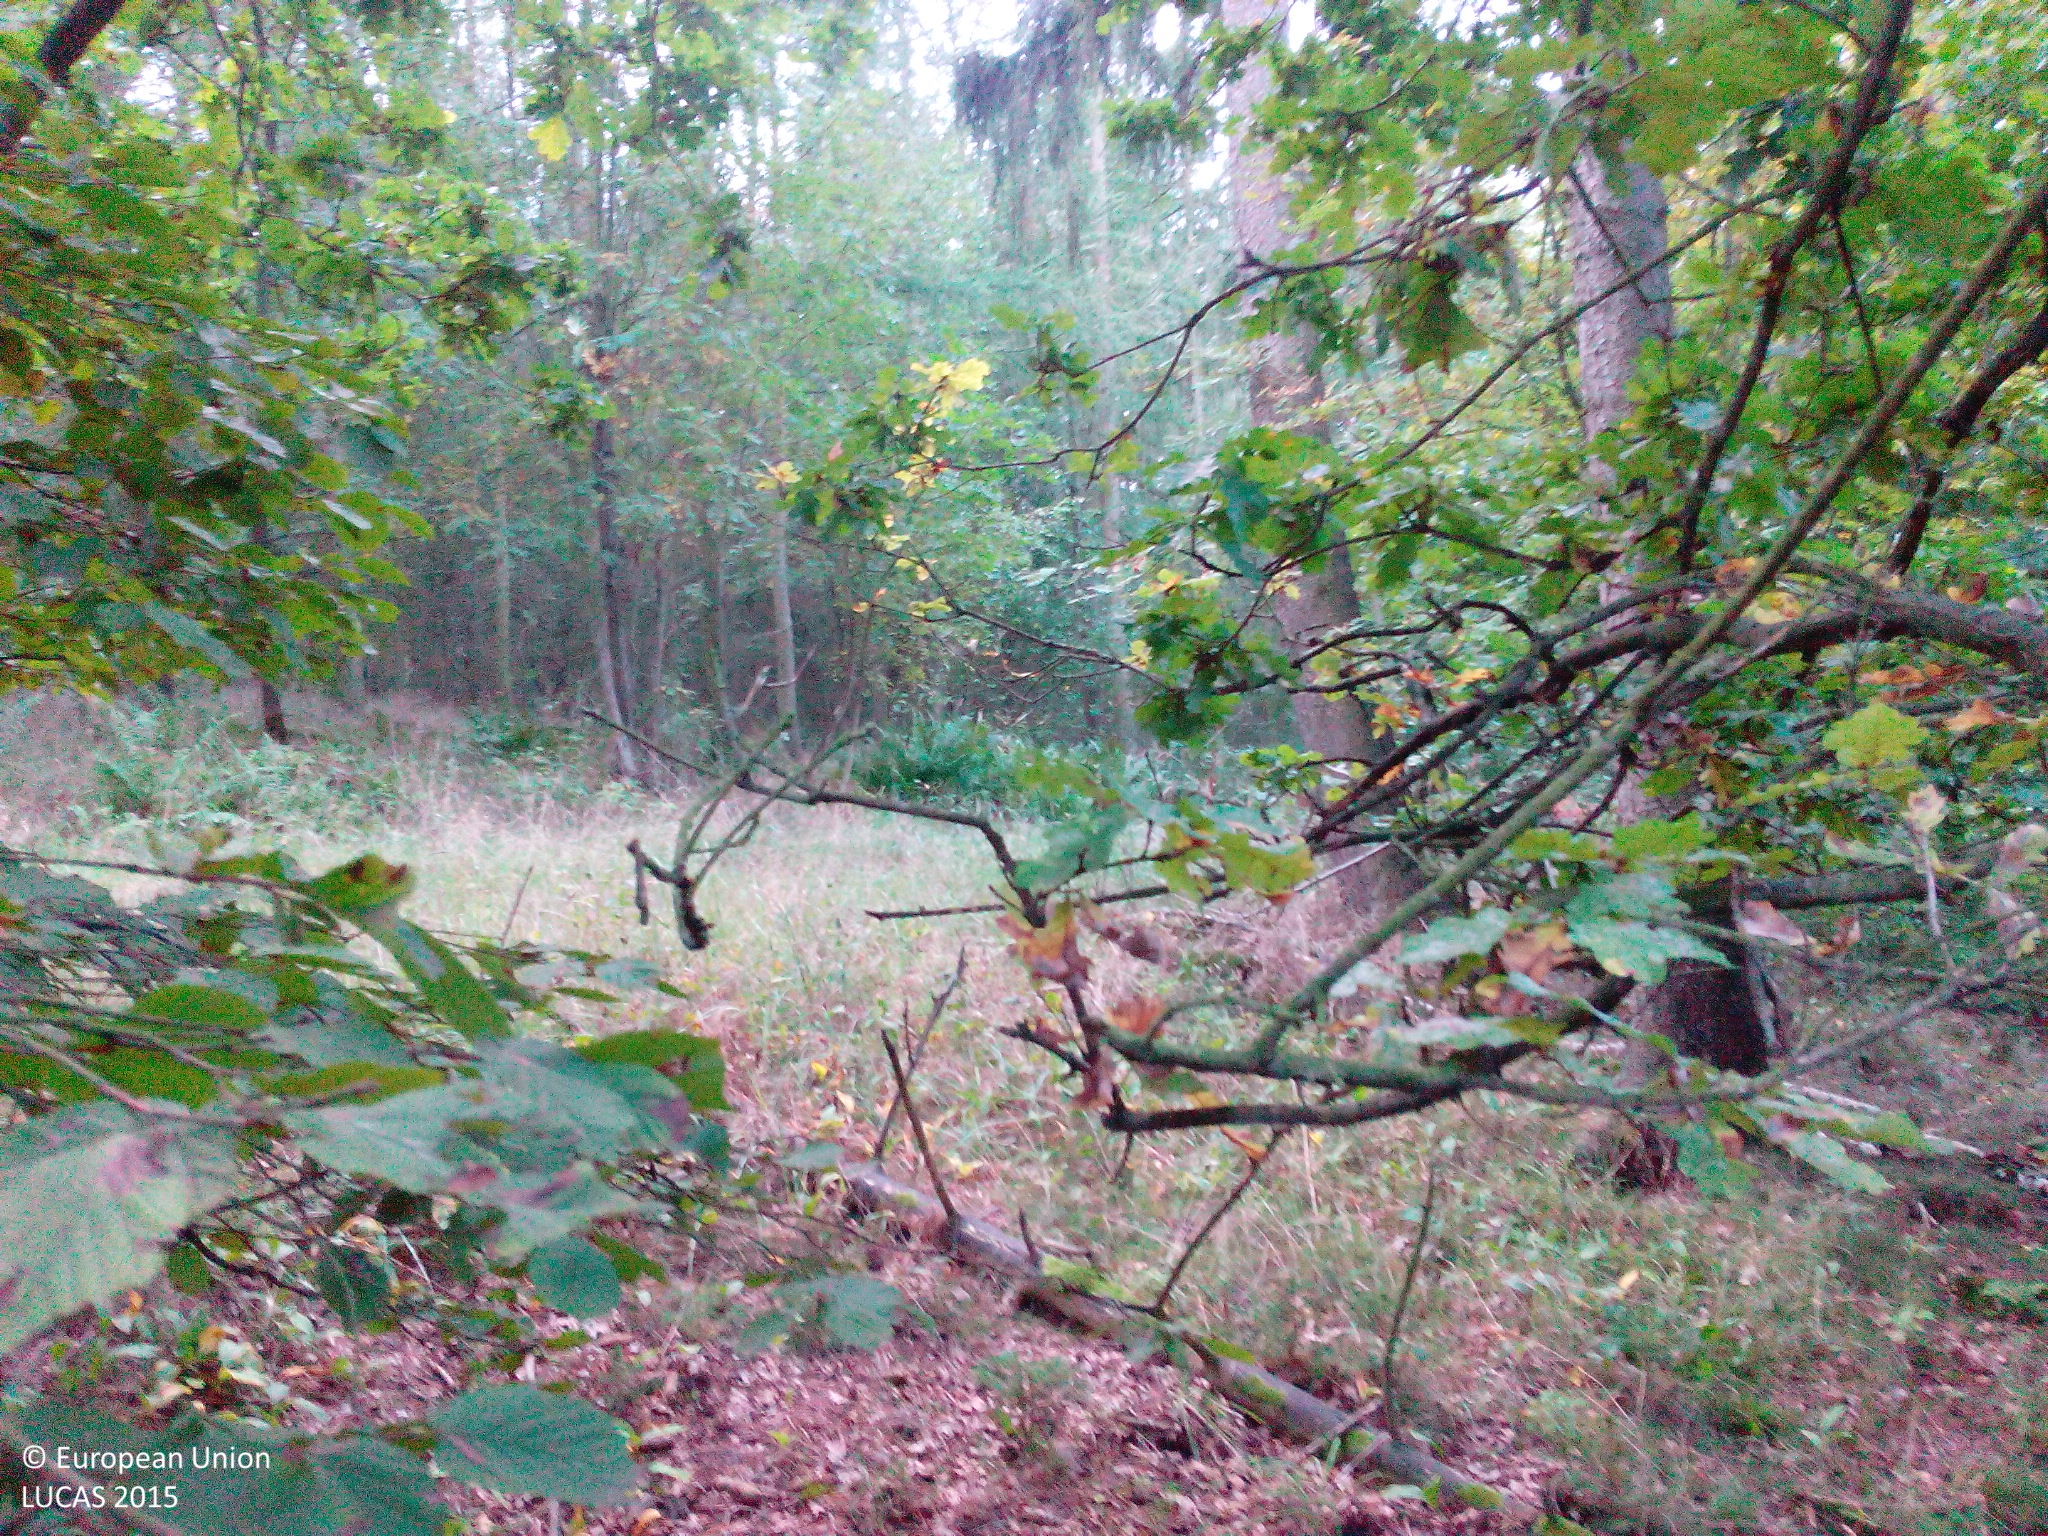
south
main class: Woodland
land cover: Spruce dominated mixed woodland
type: hemiboreal forest and nemoral coniferous forest and mixed broadleaved-coniferous forest
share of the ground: > 75 %
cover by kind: coniferous forest trees 75 %, broadleaved forest trees 25 %
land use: Forestry
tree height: > 5 m
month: September
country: DE
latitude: 51.4929
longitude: 10.9359
